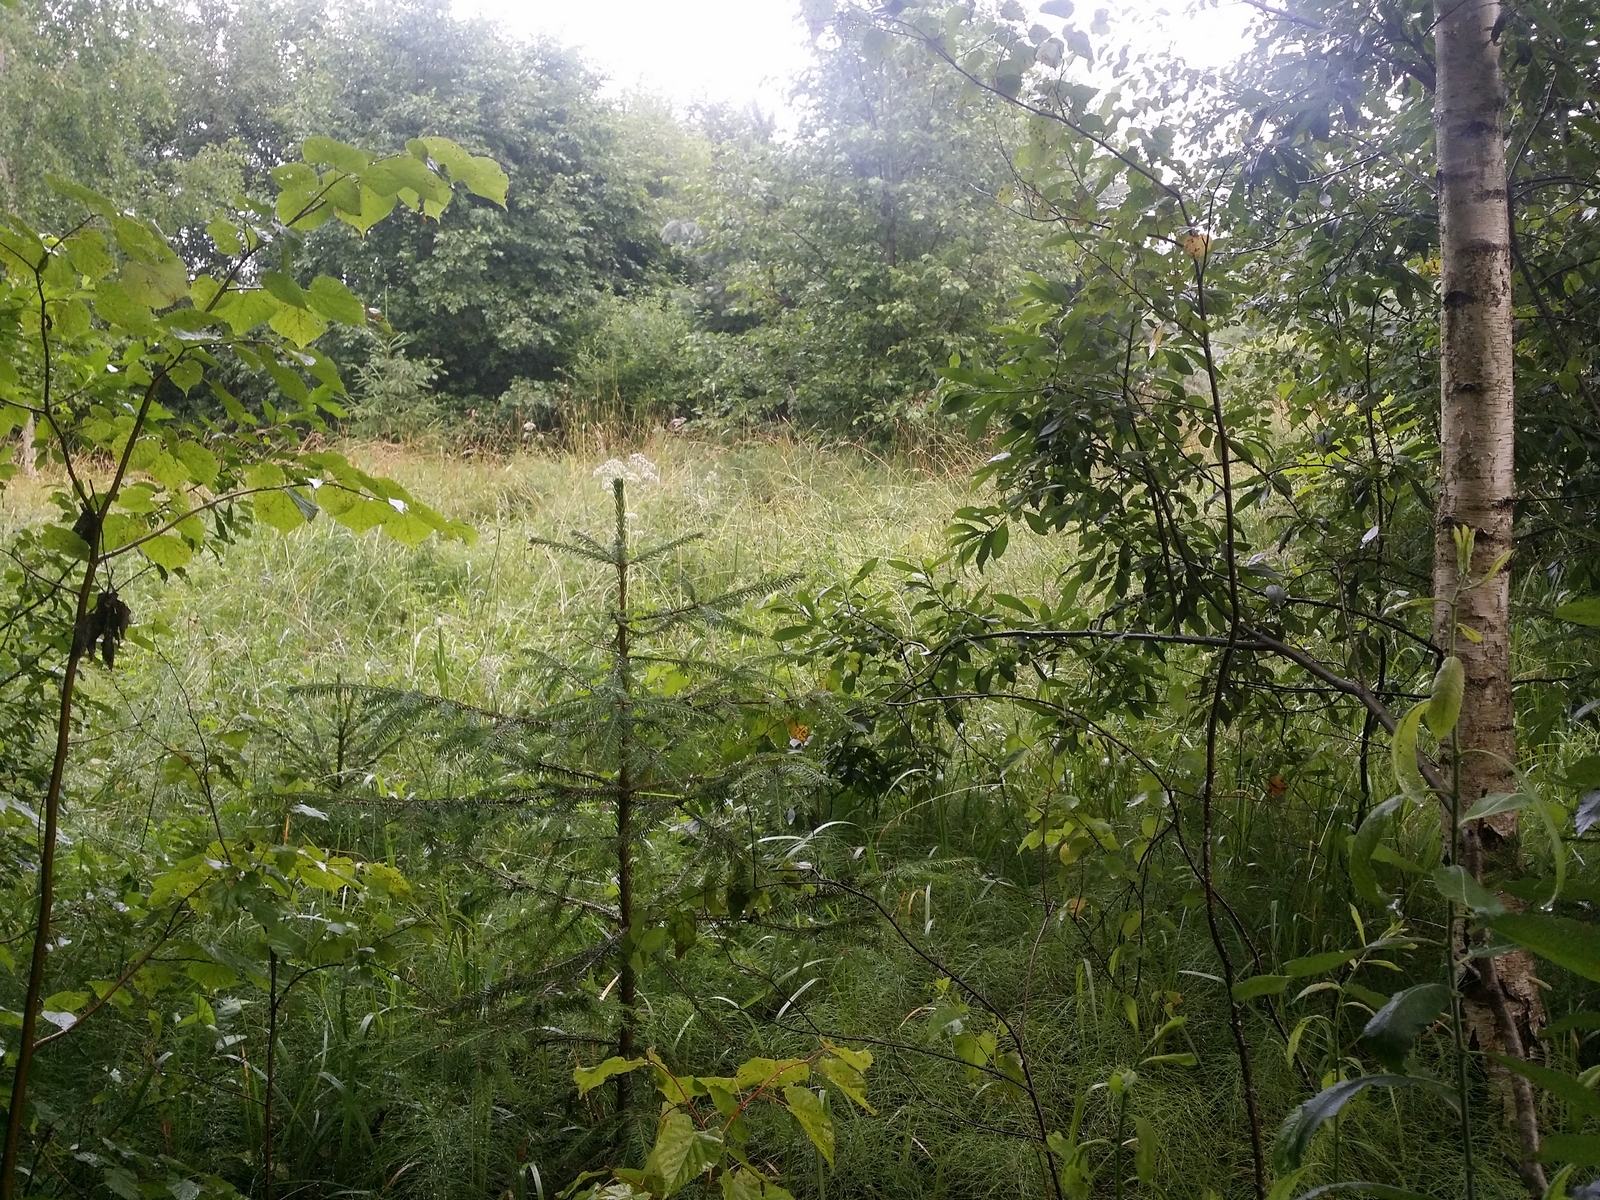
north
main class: Grassland
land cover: Spontaneously vegetated surfaces
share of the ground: > 75 %
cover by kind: herbaceous plants 100 %
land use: Agriculture (excluding fallow land and kitchen gardens)
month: July
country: LV
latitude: 57.1883
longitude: 26.6454
